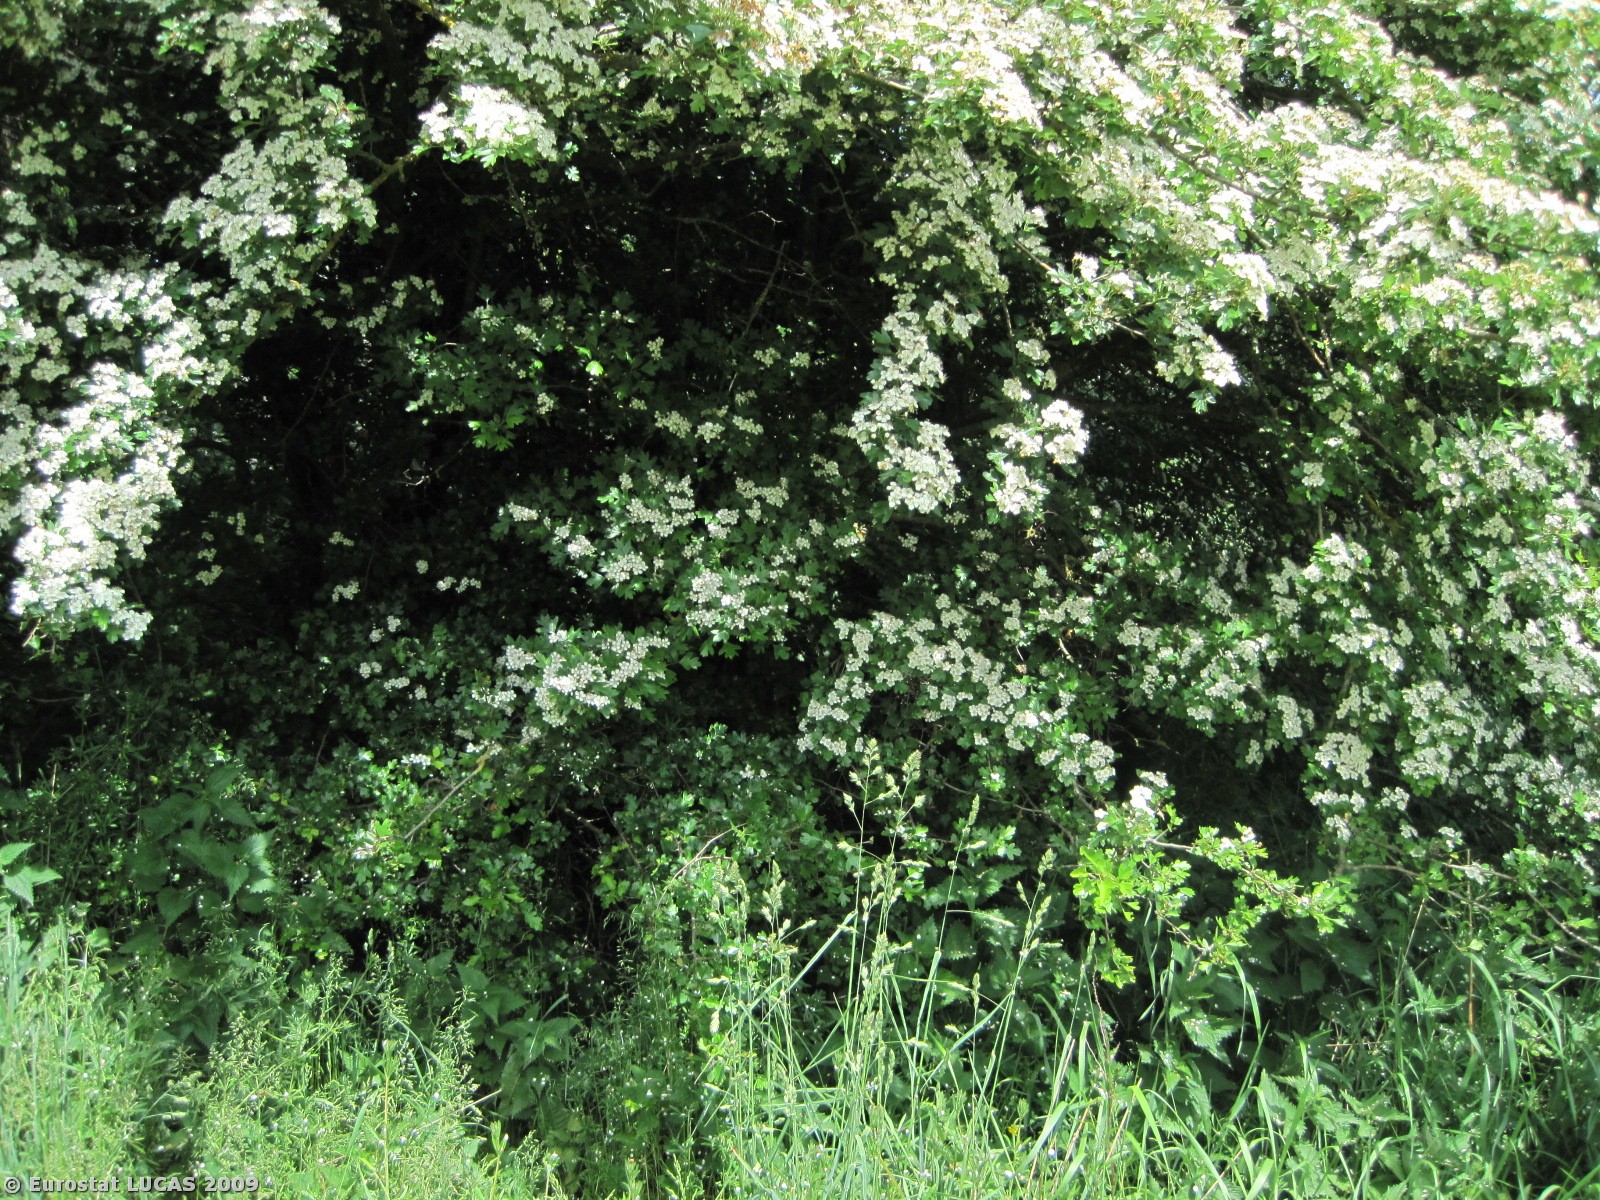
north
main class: Woodland
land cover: Coniferous woodland
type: mesophytic deciduous forest
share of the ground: > 75 %
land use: Forestry
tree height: > 5 m
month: June
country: DK
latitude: 56.9607
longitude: 10.0164
